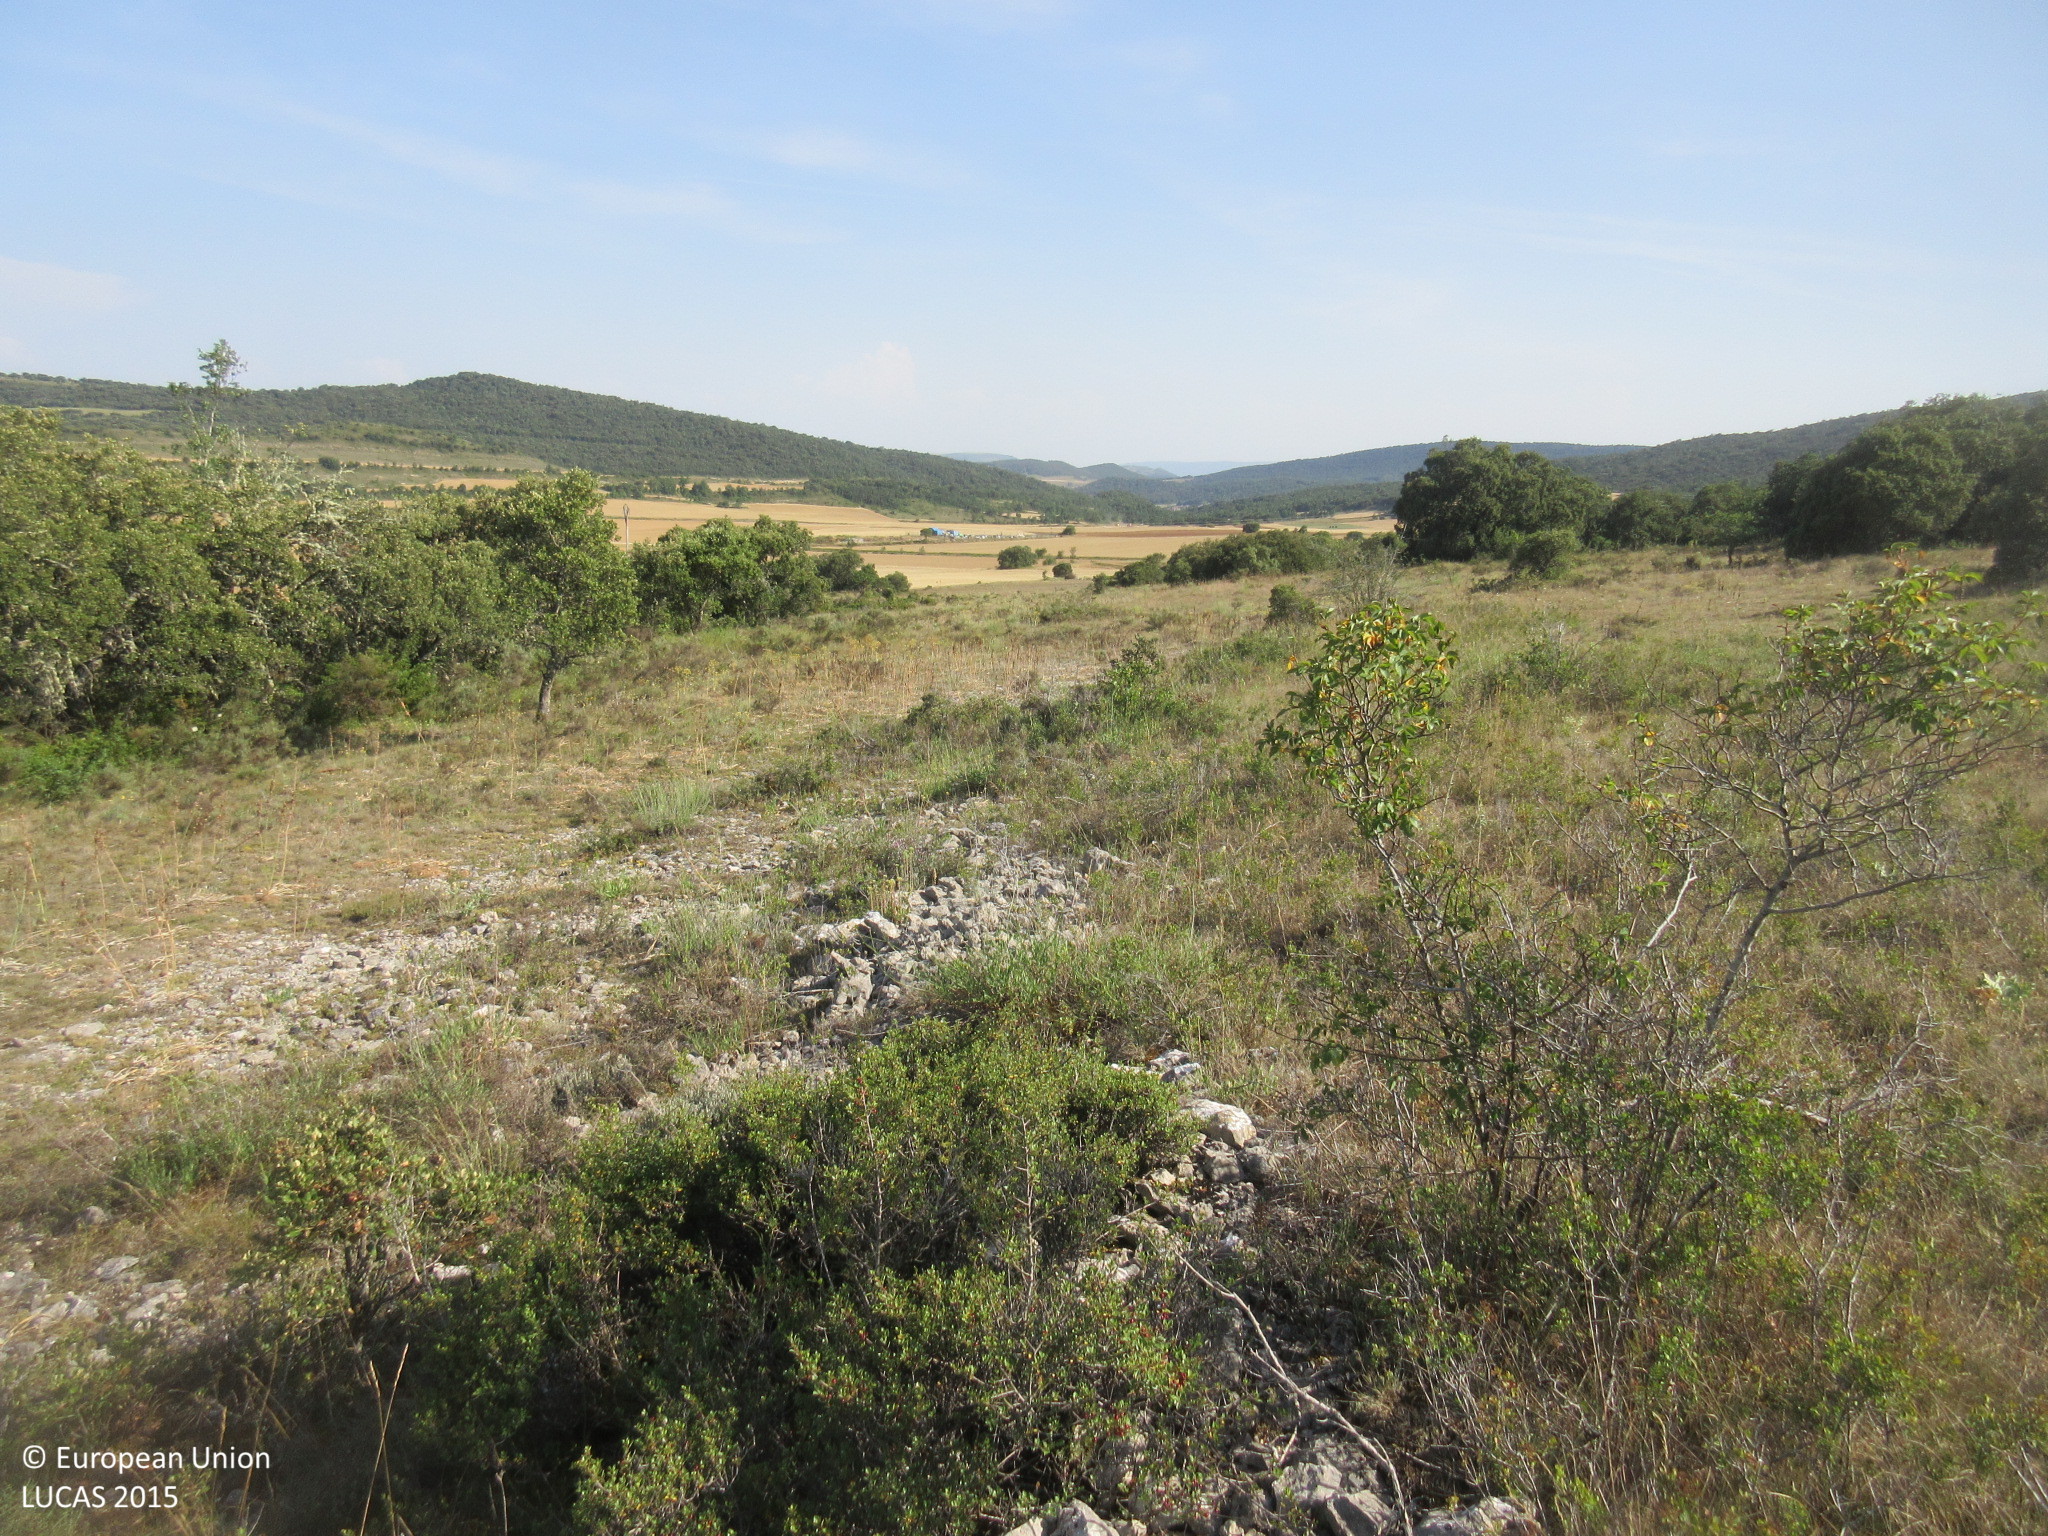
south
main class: Shrubland
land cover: Shrubland with sparse tree cover
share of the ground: 50 - 75 %
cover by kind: shrubs 60 %, herbaceous plants 35 %, broadleaved forest trees 5 %
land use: Semi-natural and natural areas not in use
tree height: < 5 m
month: July
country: ES
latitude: 43.0314
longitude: -3.4539
